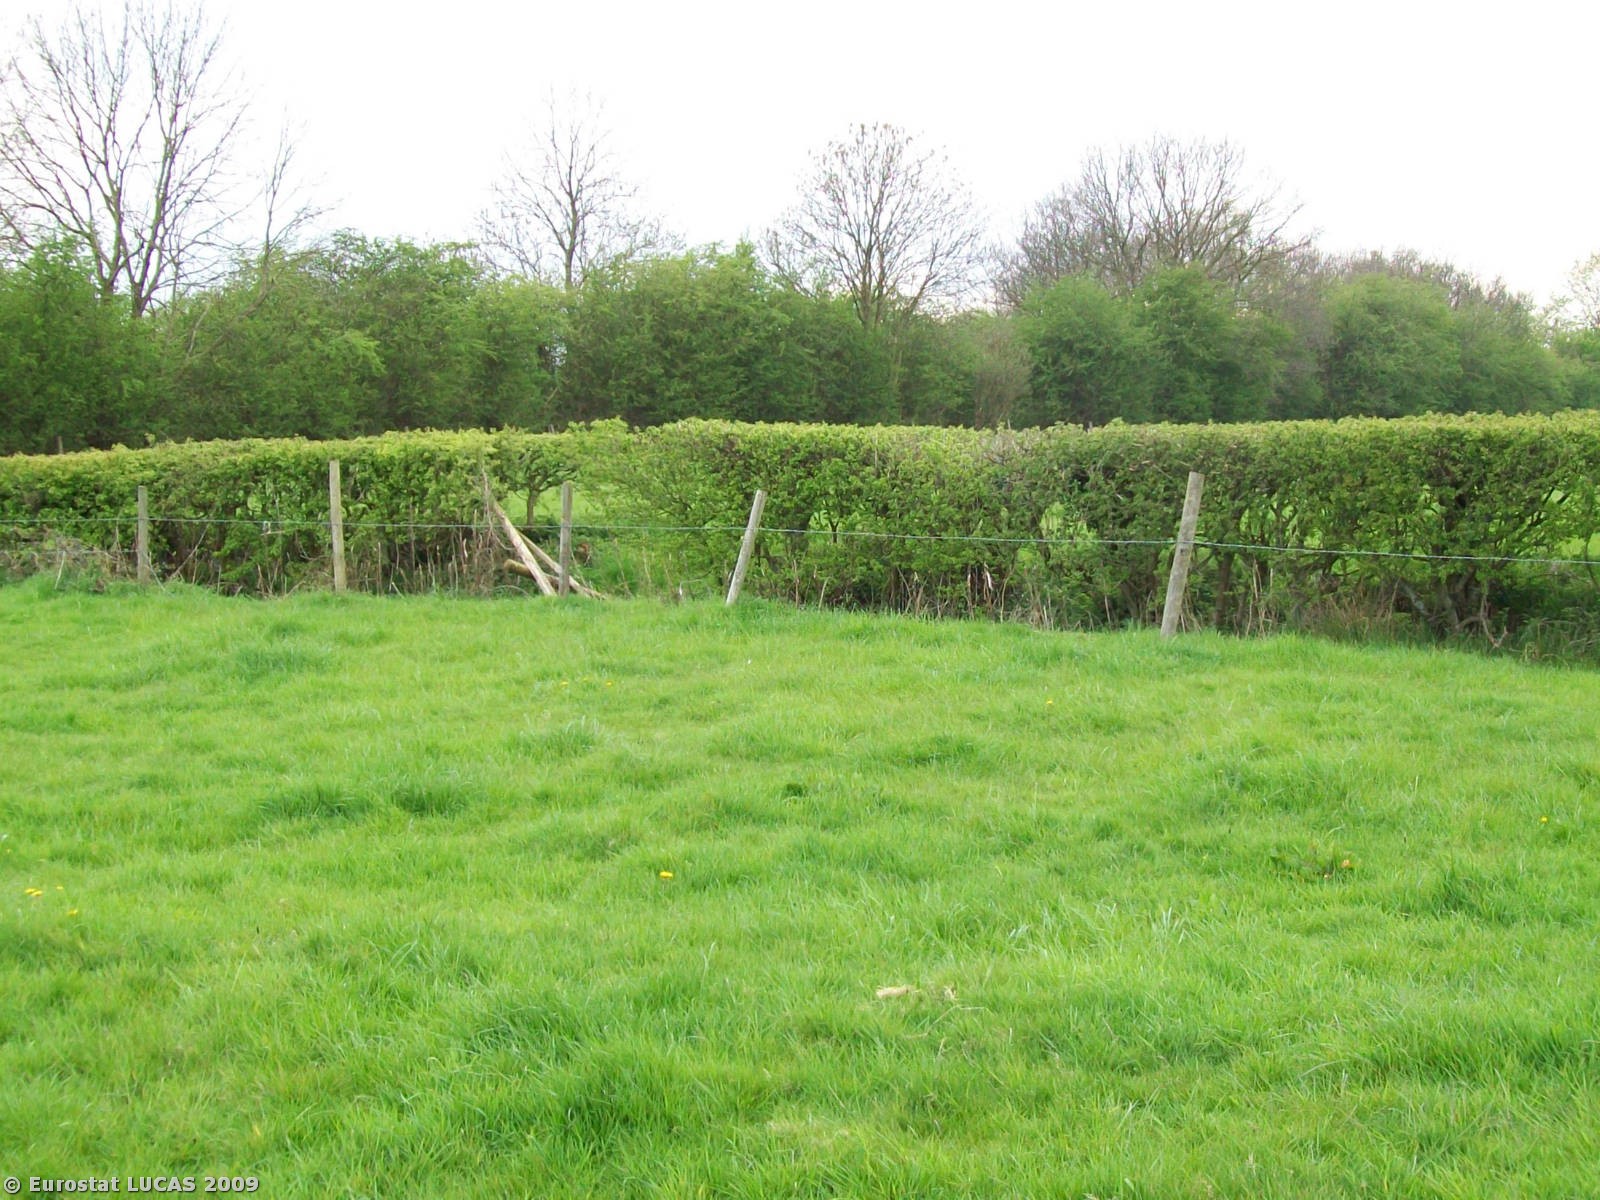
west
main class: Grassland
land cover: Grassland with sparse tree/shrub cover
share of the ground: > 75 %
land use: Agriculture (excluding fallow land and kitchen gardens)
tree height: > 5 m
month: April
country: GB
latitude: 52.9965
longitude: -1.5083
